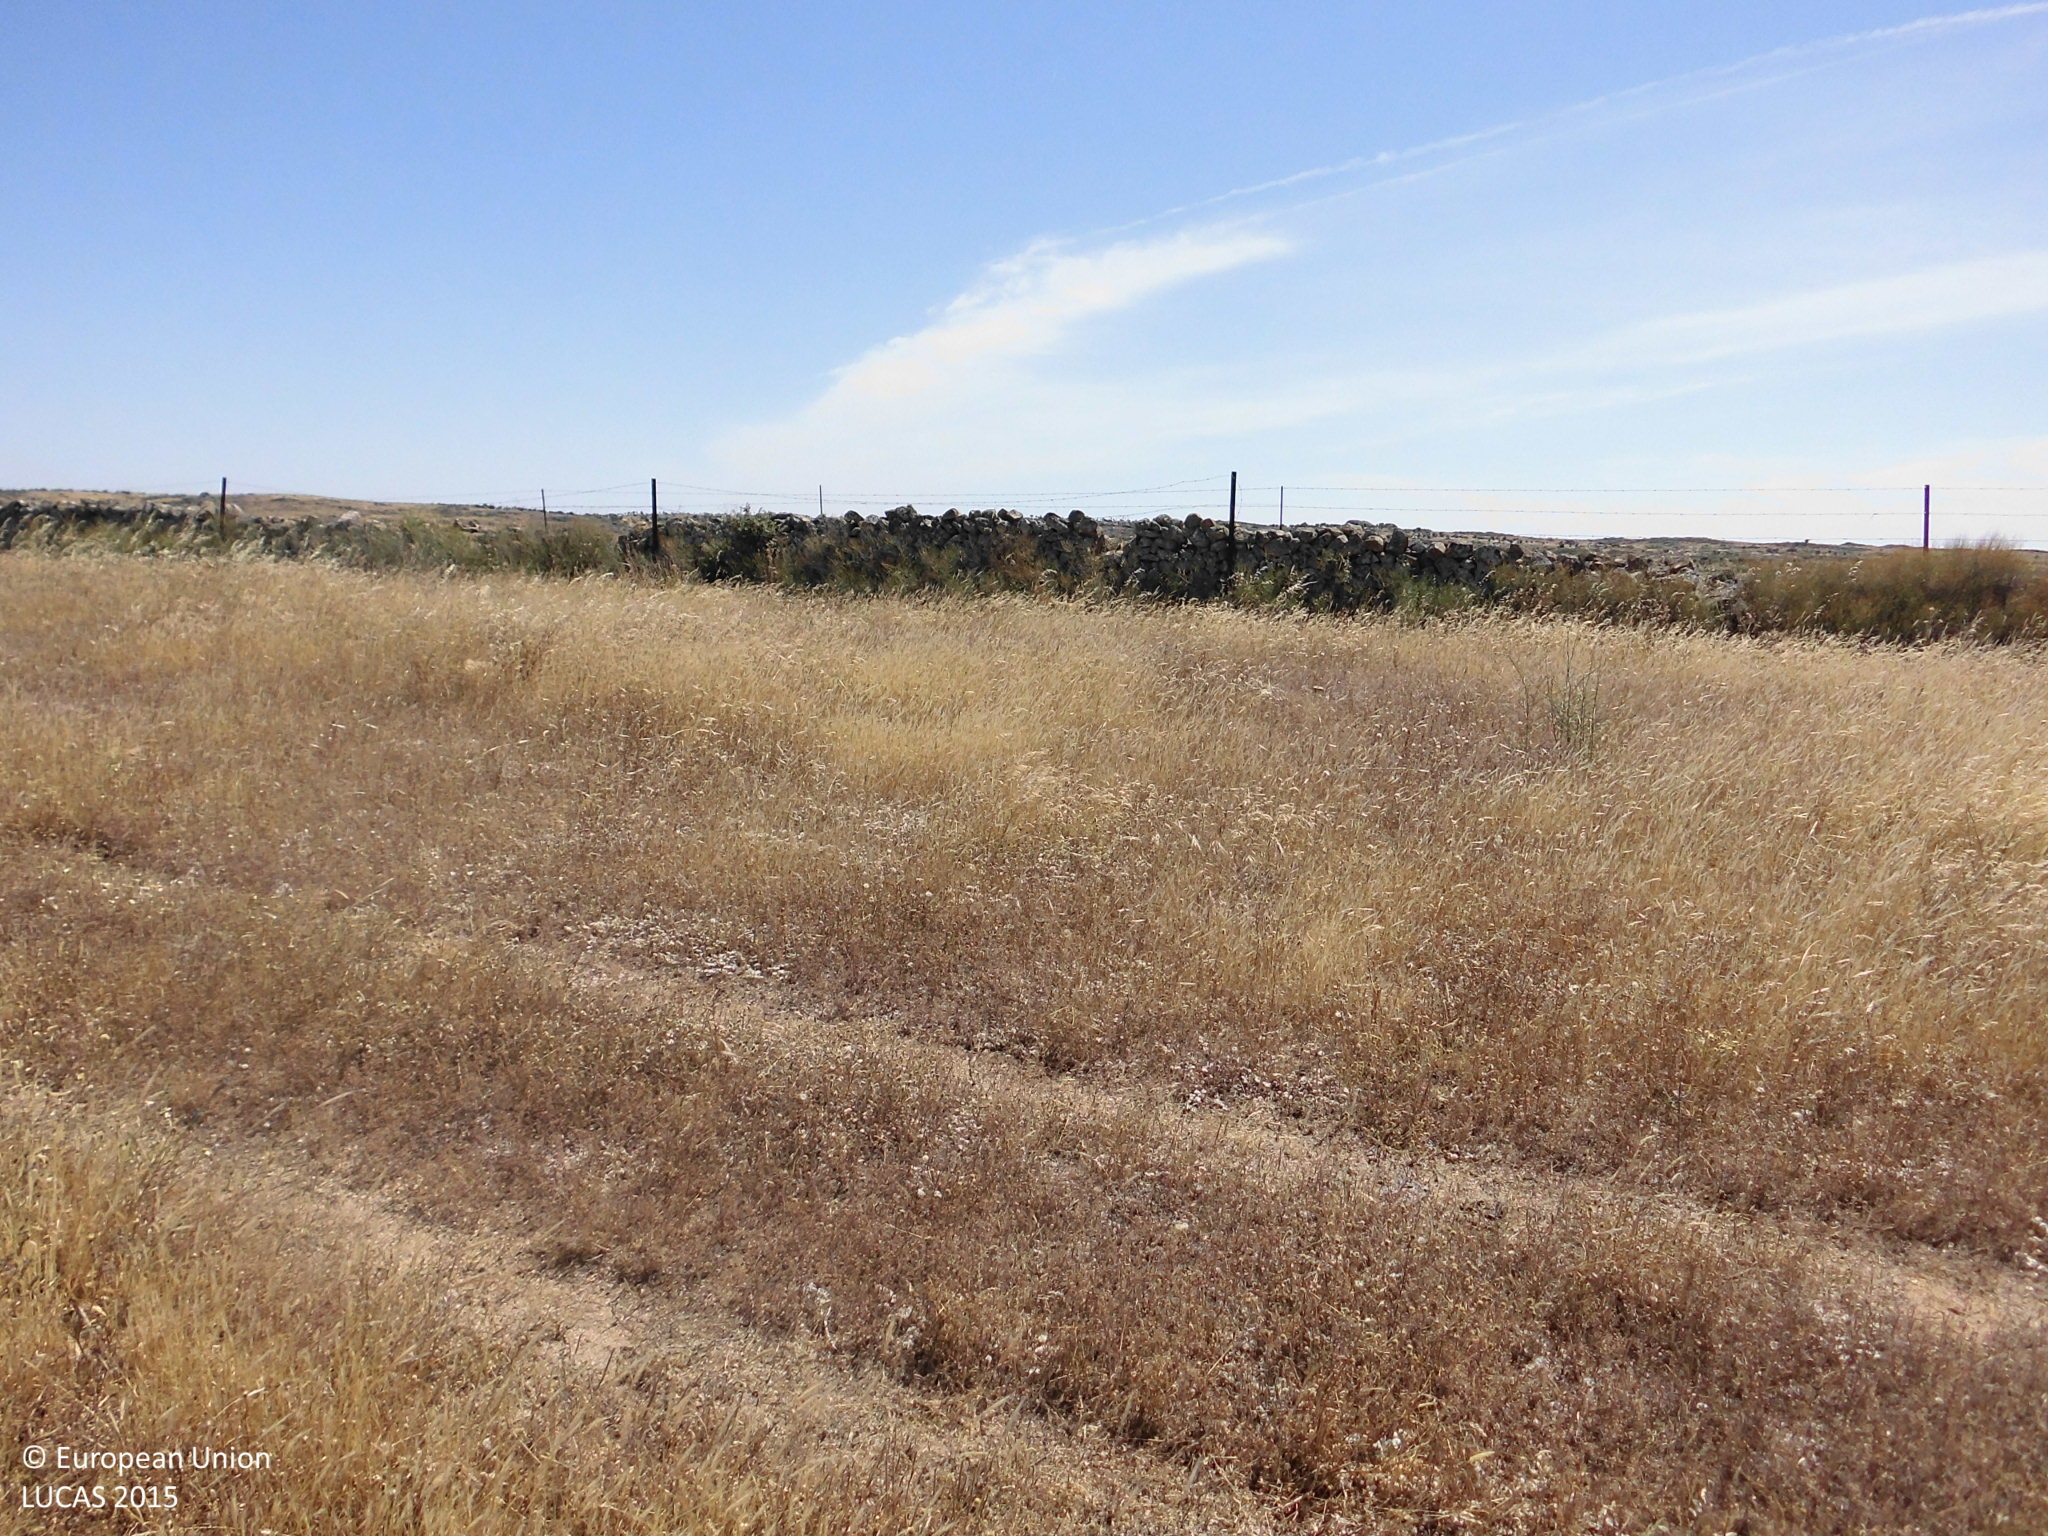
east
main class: Grassland
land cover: Grassland without tree/shrub cover
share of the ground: > 75 %
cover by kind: herbaceous plants 100 %
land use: Agriculture (excluding fallow land and kitchen gardens)
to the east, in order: Grassland without tree/shrub cover; Tracks; Grassland without tree/shrub cover; Dry stone walls; Grassland without tree/shrub cover; Rivers and streams; Grassland without tree/shrub cover
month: May
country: ES
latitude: 39.6994
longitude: -6.6497
